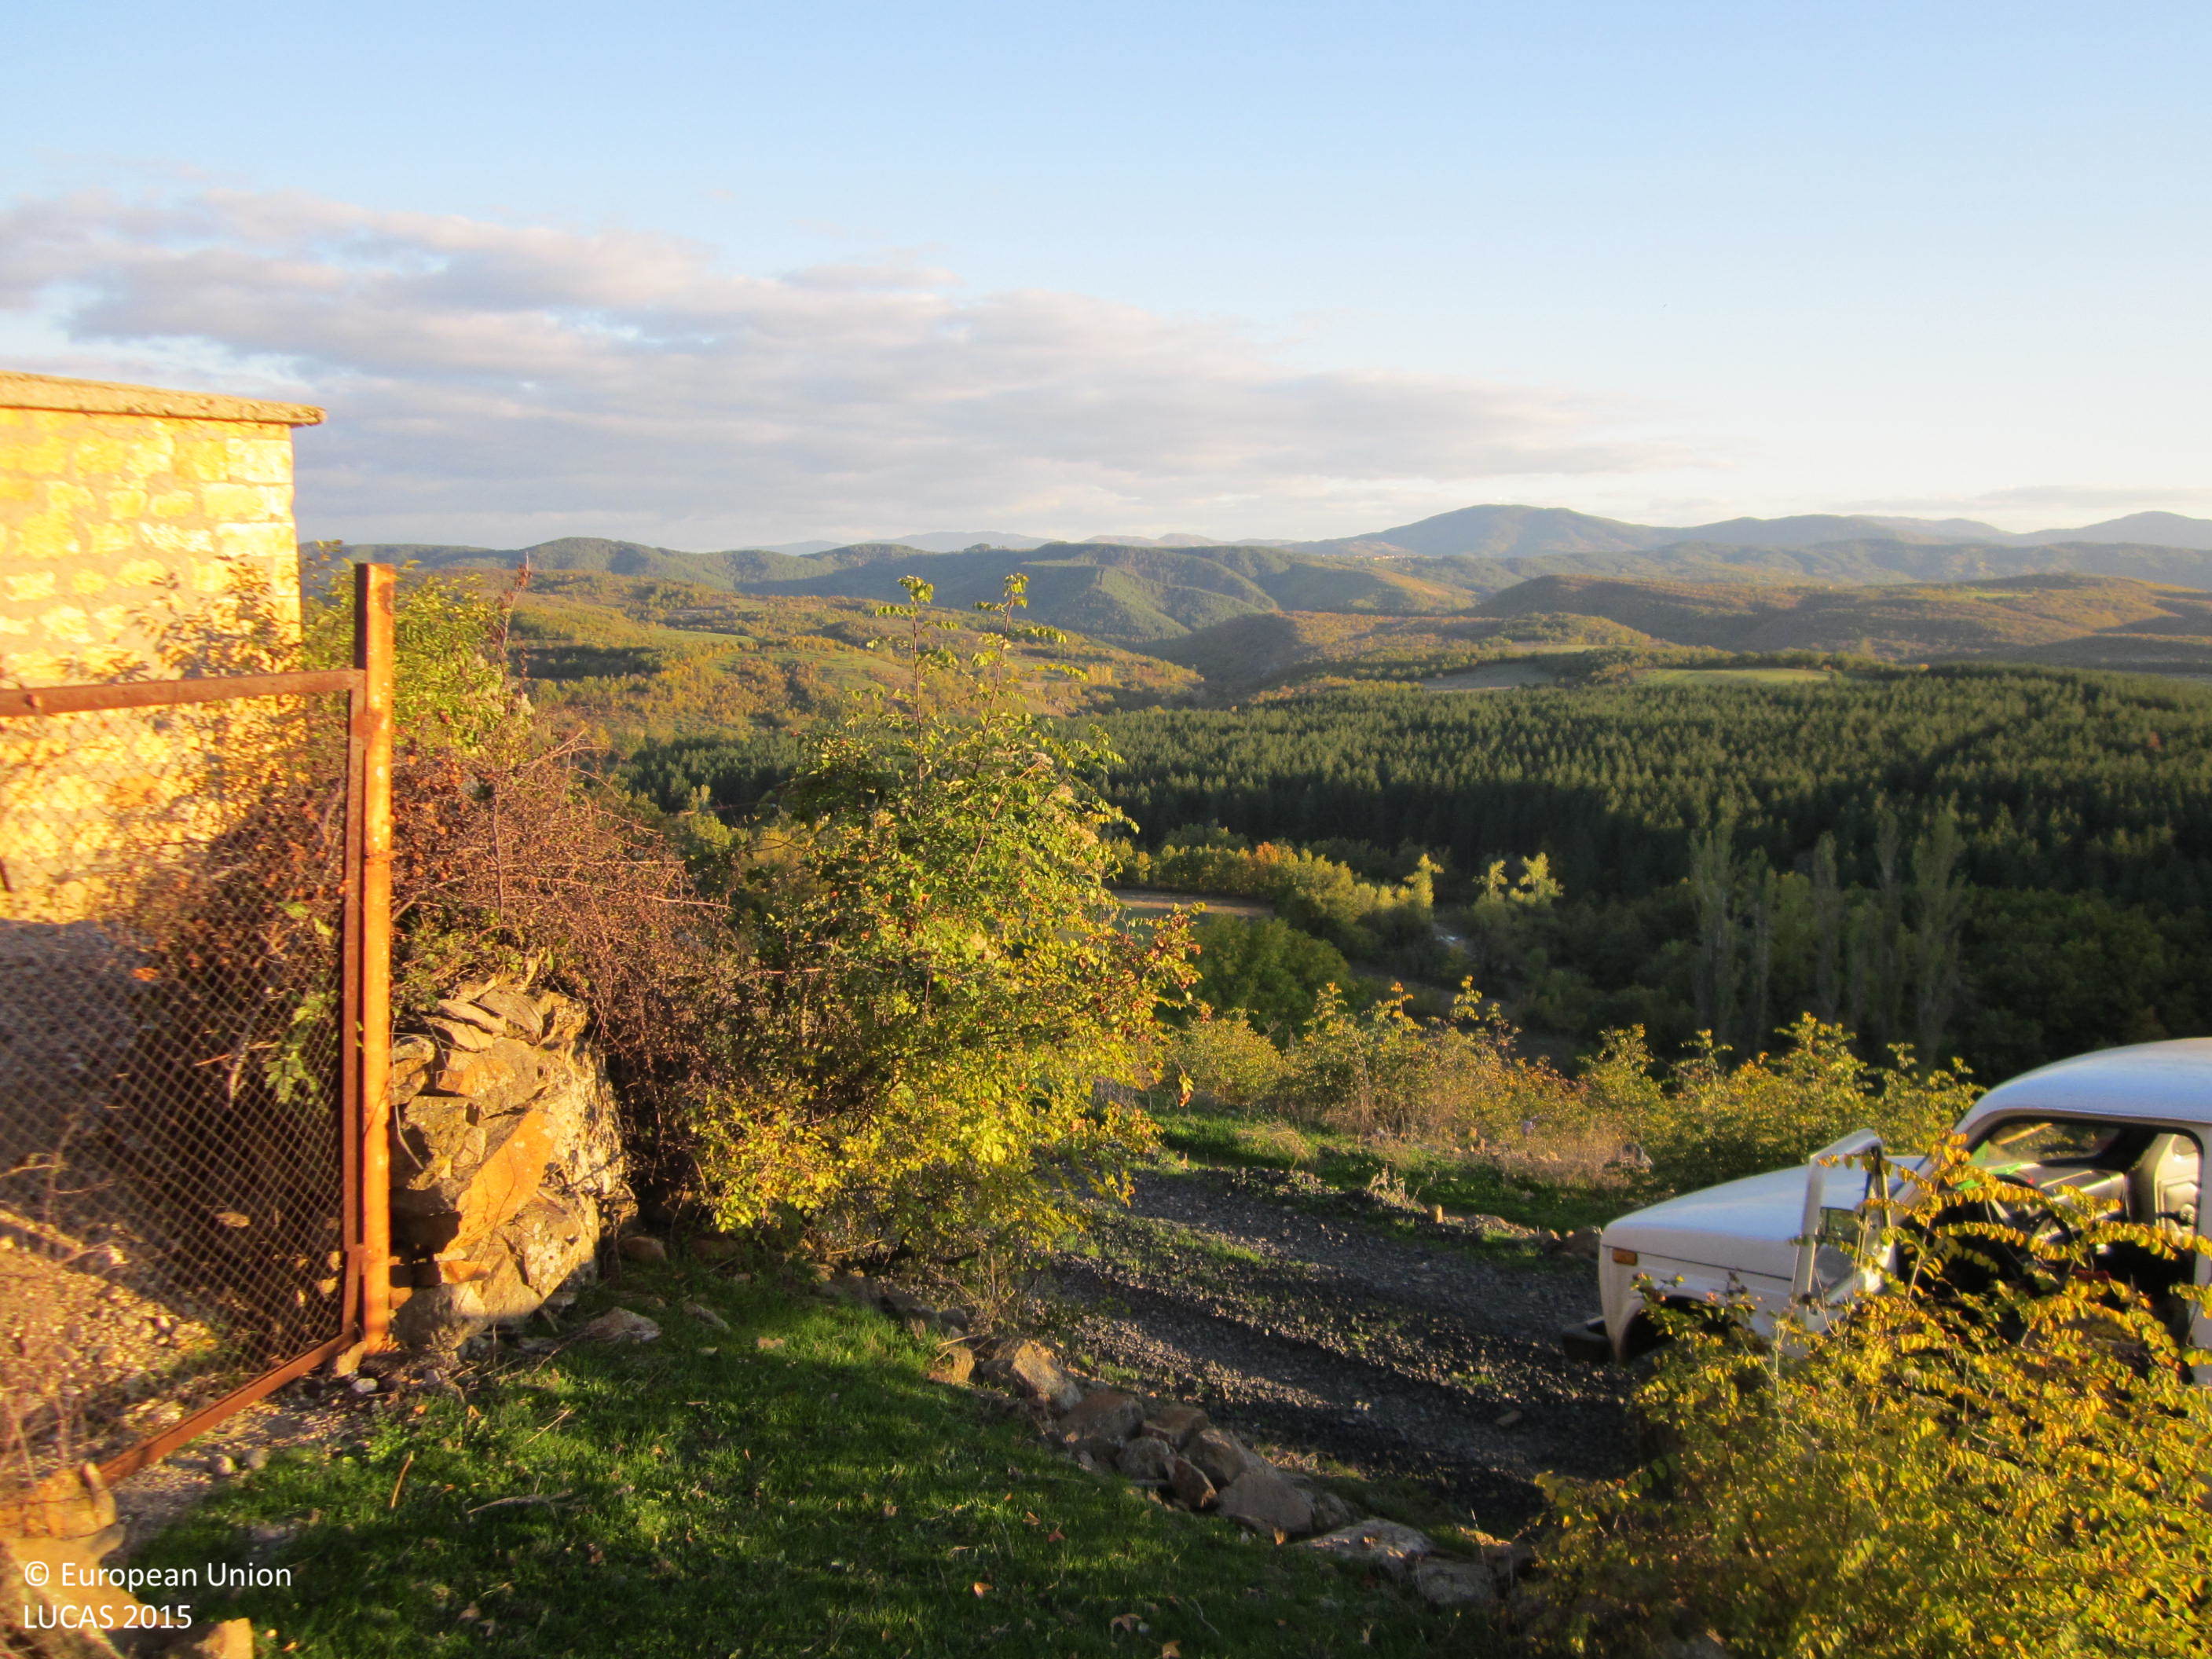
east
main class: Grassland
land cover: Grassland without tree/shrub cover
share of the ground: 50 - 75 %
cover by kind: herbaceous plants 50 %, shrubs 5 %
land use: Residential
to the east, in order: Grassland without tree/shrub cover; Artificial constructions in urban areas; Grassland with sparse tree/shrub cover; Shrubland with sparse tree cover; Grassland with sparse tree/shrub cover; Shrubland with sparse tree cover; Grassland with sparse tree/shrub cover; Grassland without tree/shrub cover
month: October
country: BG
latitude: 41.4610
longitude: 25.5623
